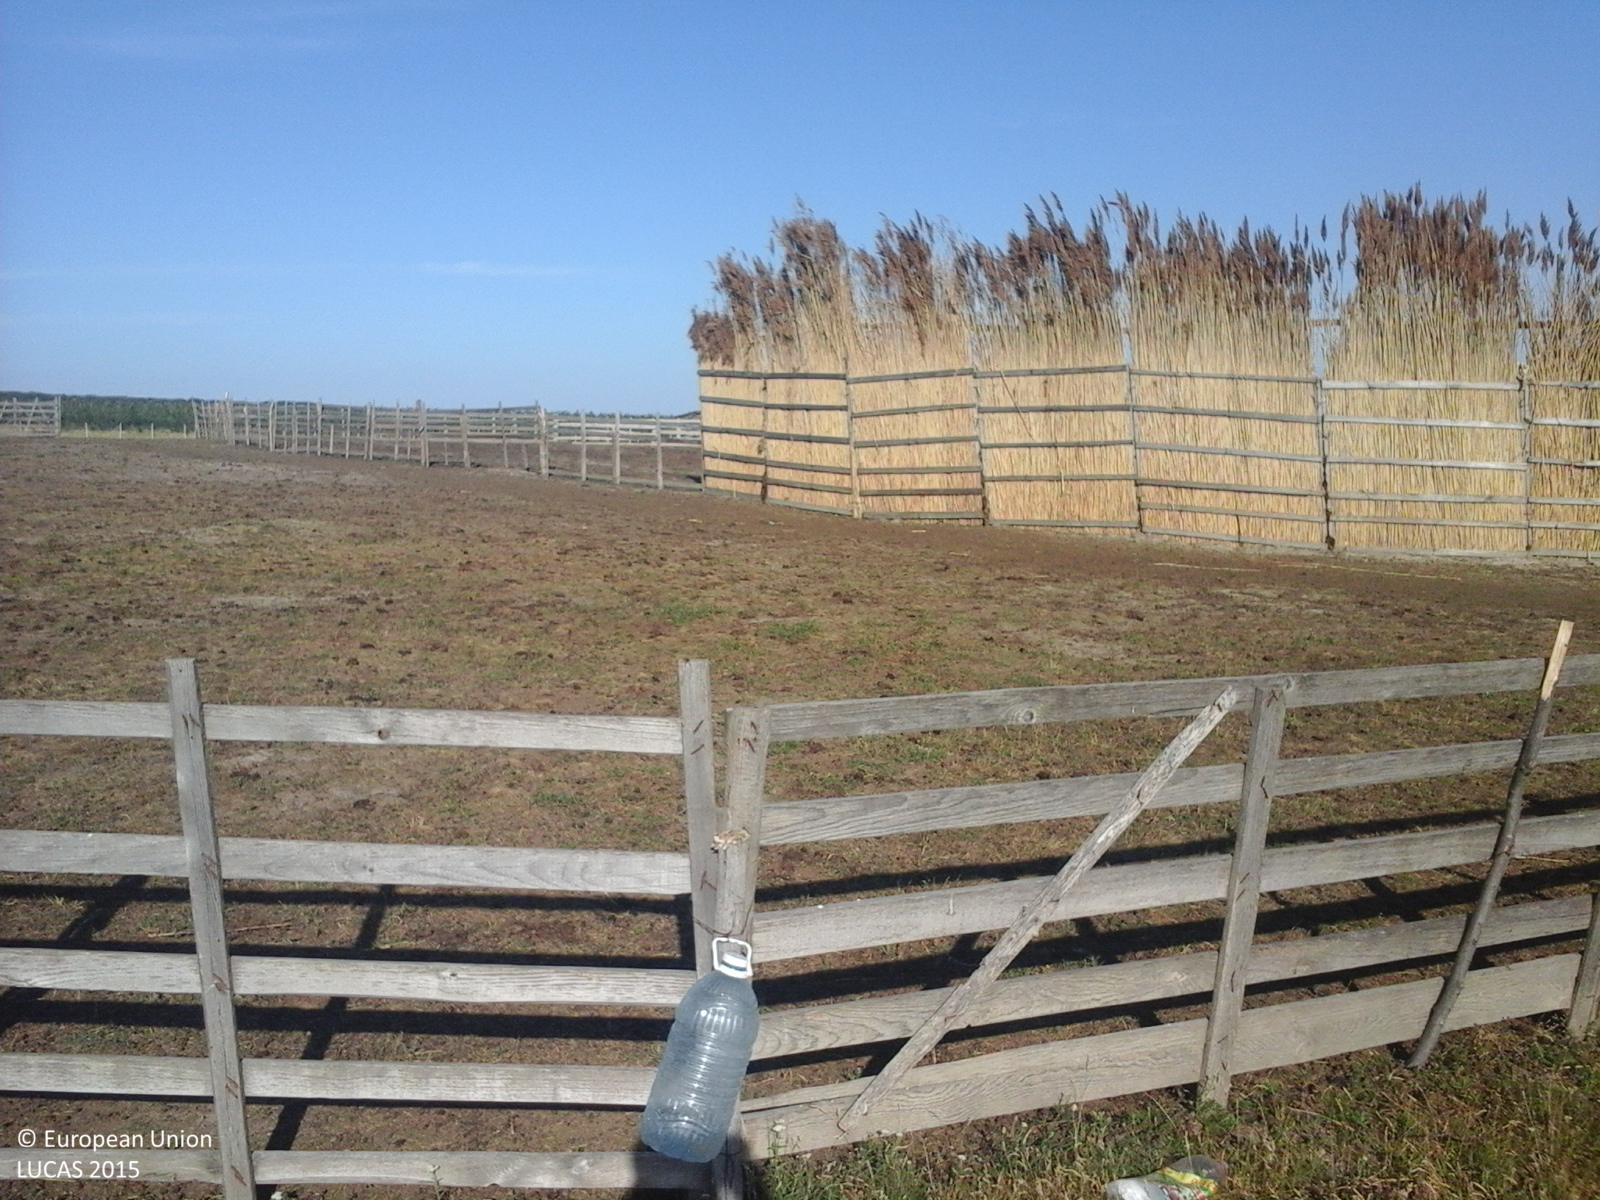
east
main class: Grassland
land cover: Grassland without tree/shrub cover
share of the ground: 25 - 50 %
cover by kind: unconsolidated bare surface 60 %, herbaceous plants 40 %
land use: Agriculture (excluding fallow land and kitchen gardens)
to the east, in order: Grassland without tree/shrub cover; Fences; Tracks; Grassland without tree/shrub cover; Cherry fruit
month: June
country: RO
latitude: 47.6702
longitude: 26.9503
